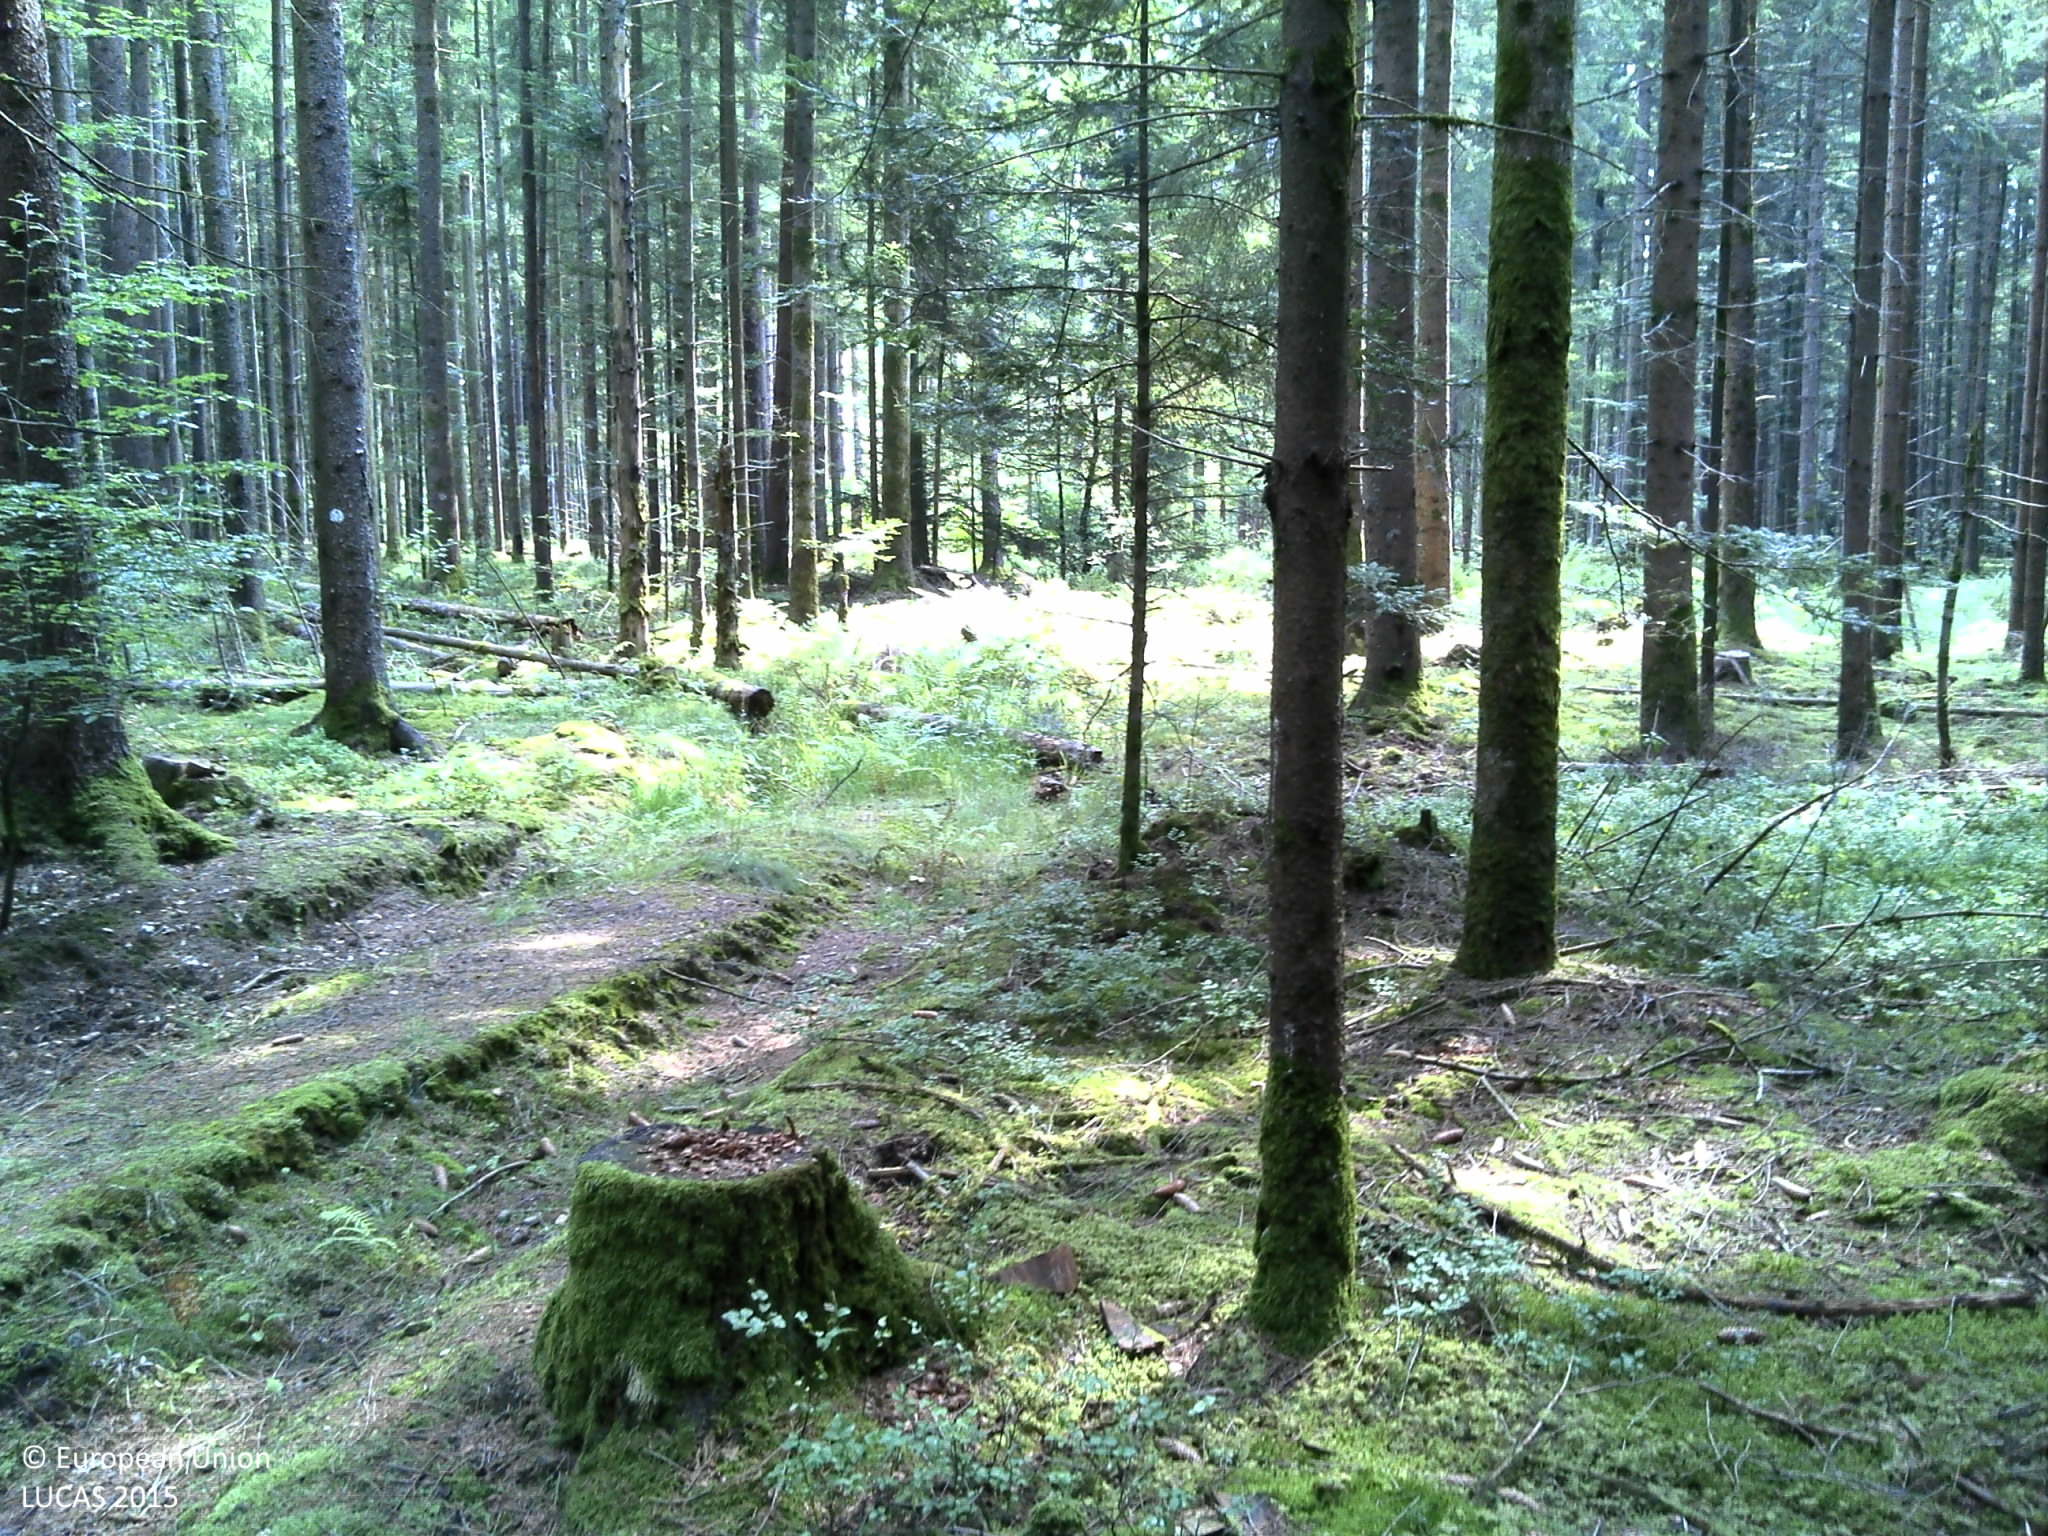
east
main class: Woodland
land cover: Spruce dominated coniferous woodland
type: exotic forest
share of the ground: > 75 %
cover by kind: coniferous forest trees 95 %, lichens and mosses 5 %
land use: Forestry
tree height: > 5 m
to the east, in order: Spruce dominated coniferous woodland; Broadleaved woodland
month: August
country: FR
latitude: 48.3393
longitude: 6.8034
